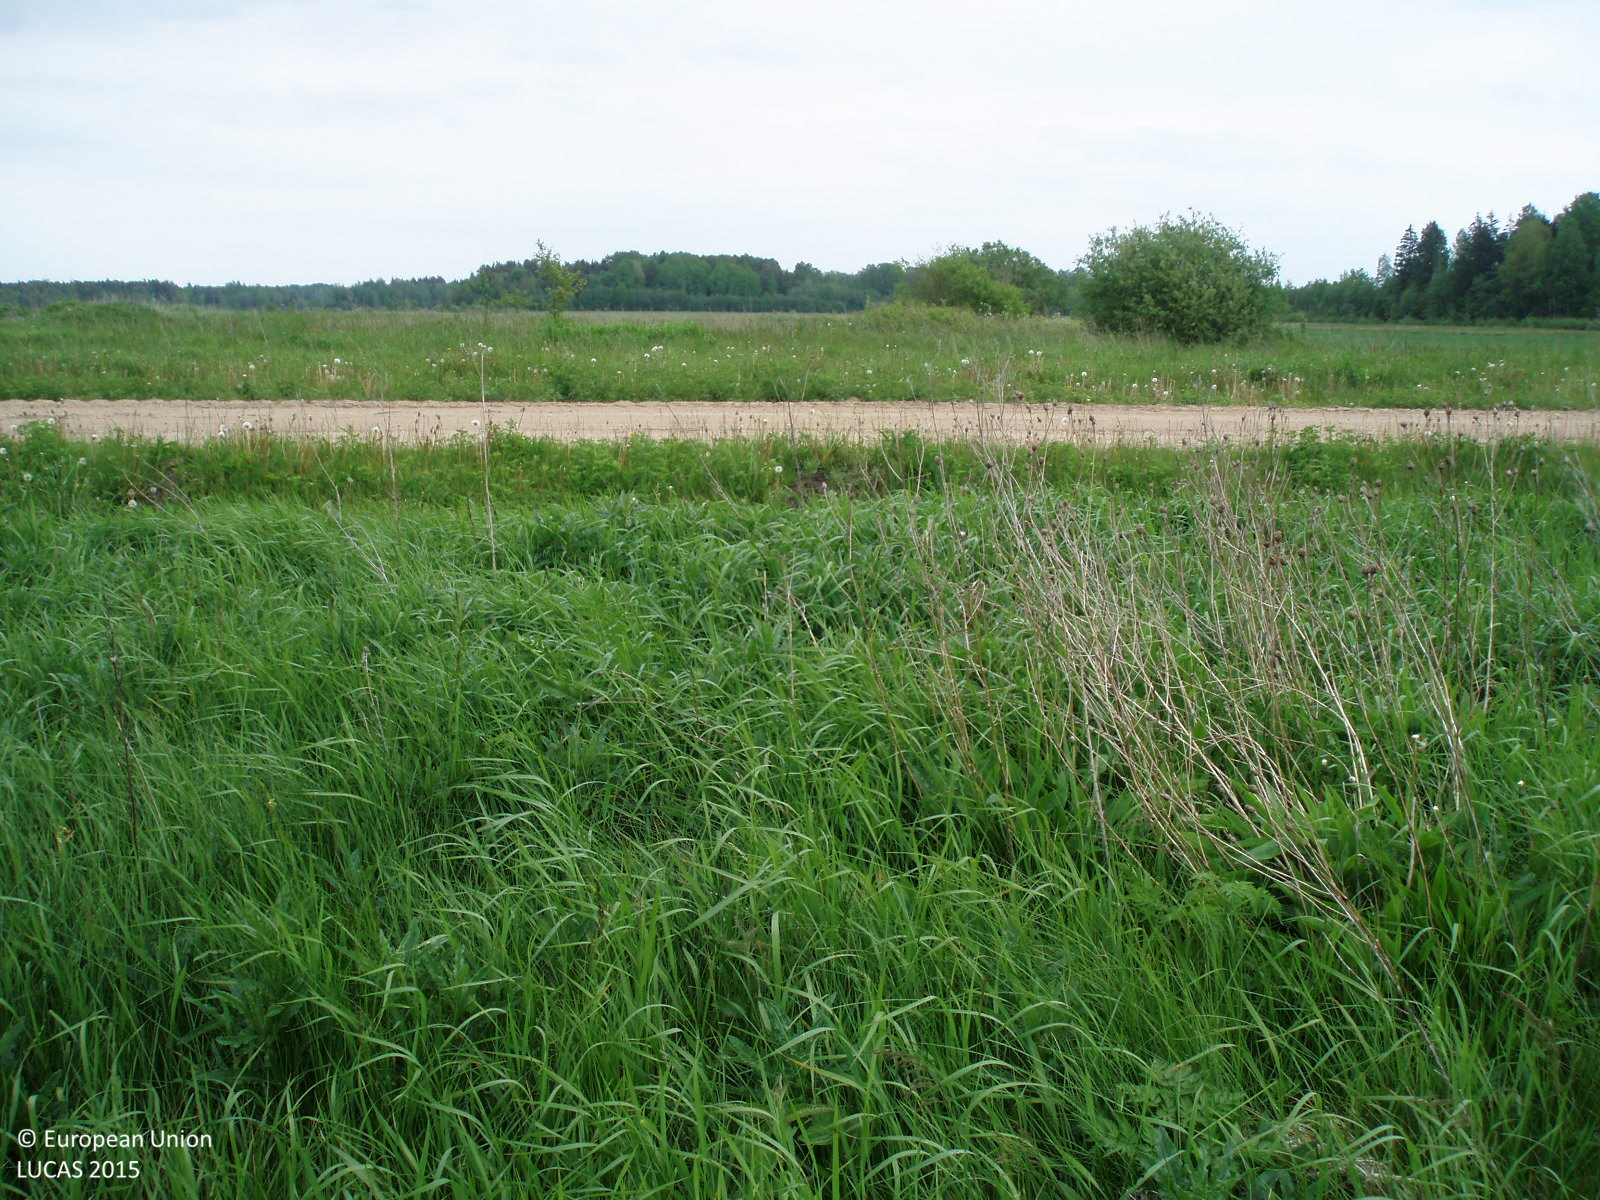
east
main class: Grassland
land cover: Grassland without tree/shrub cover
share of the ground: > 75 %
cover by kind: herbaceous plants 100 %
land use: Agriculture (excluding fallow land and kitchen gardens)
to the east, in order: Grassland without tree/shrub cover; Paved roads, cycling and walking lanes; Grassland with sparse tree/shrub cover; Grassland without tree/shrub cover; Triticale; Fences; Grassland without tree/shrub cover
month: May
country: LT
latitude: 56.1177
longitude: 22.5241
